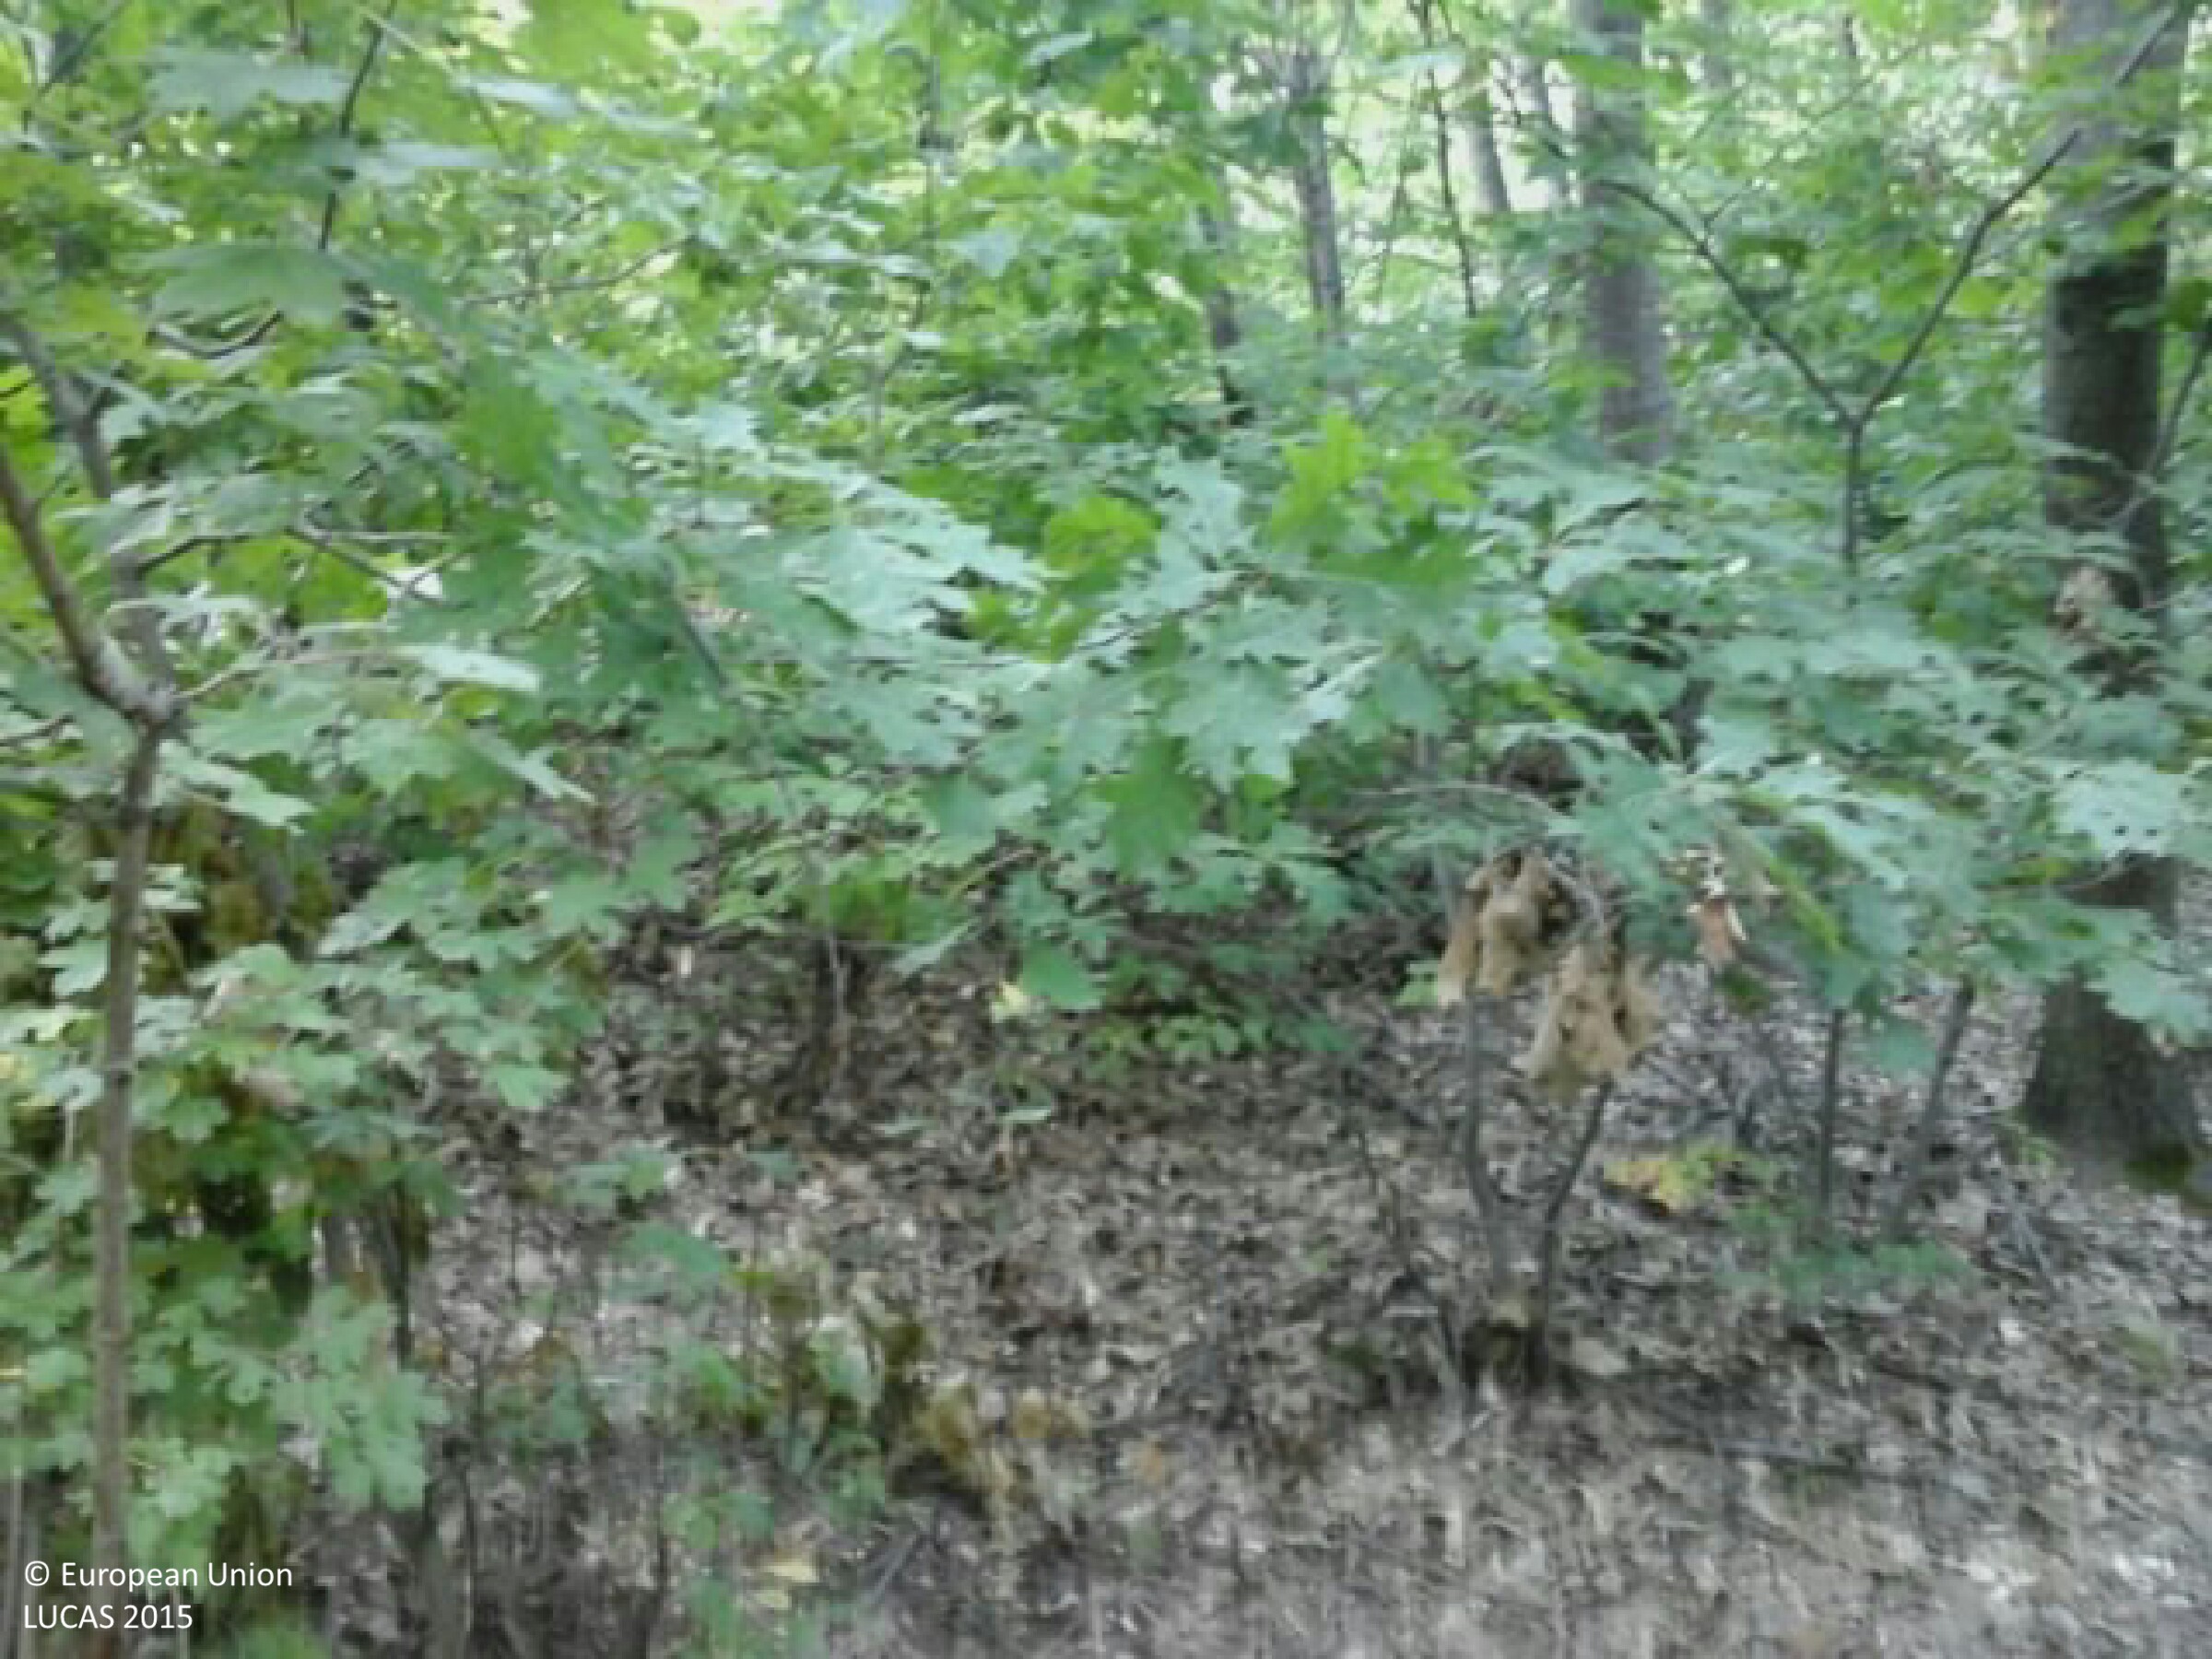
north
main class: Woodland
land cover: Broadleaved woodland
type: mesophytic deciduous forest
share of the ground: > 75 %
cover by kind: broadleaved forest trees 100 %
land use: Forestry
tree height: > 5 m
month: September
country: HU
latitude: 48.1438
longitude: 19.8516
